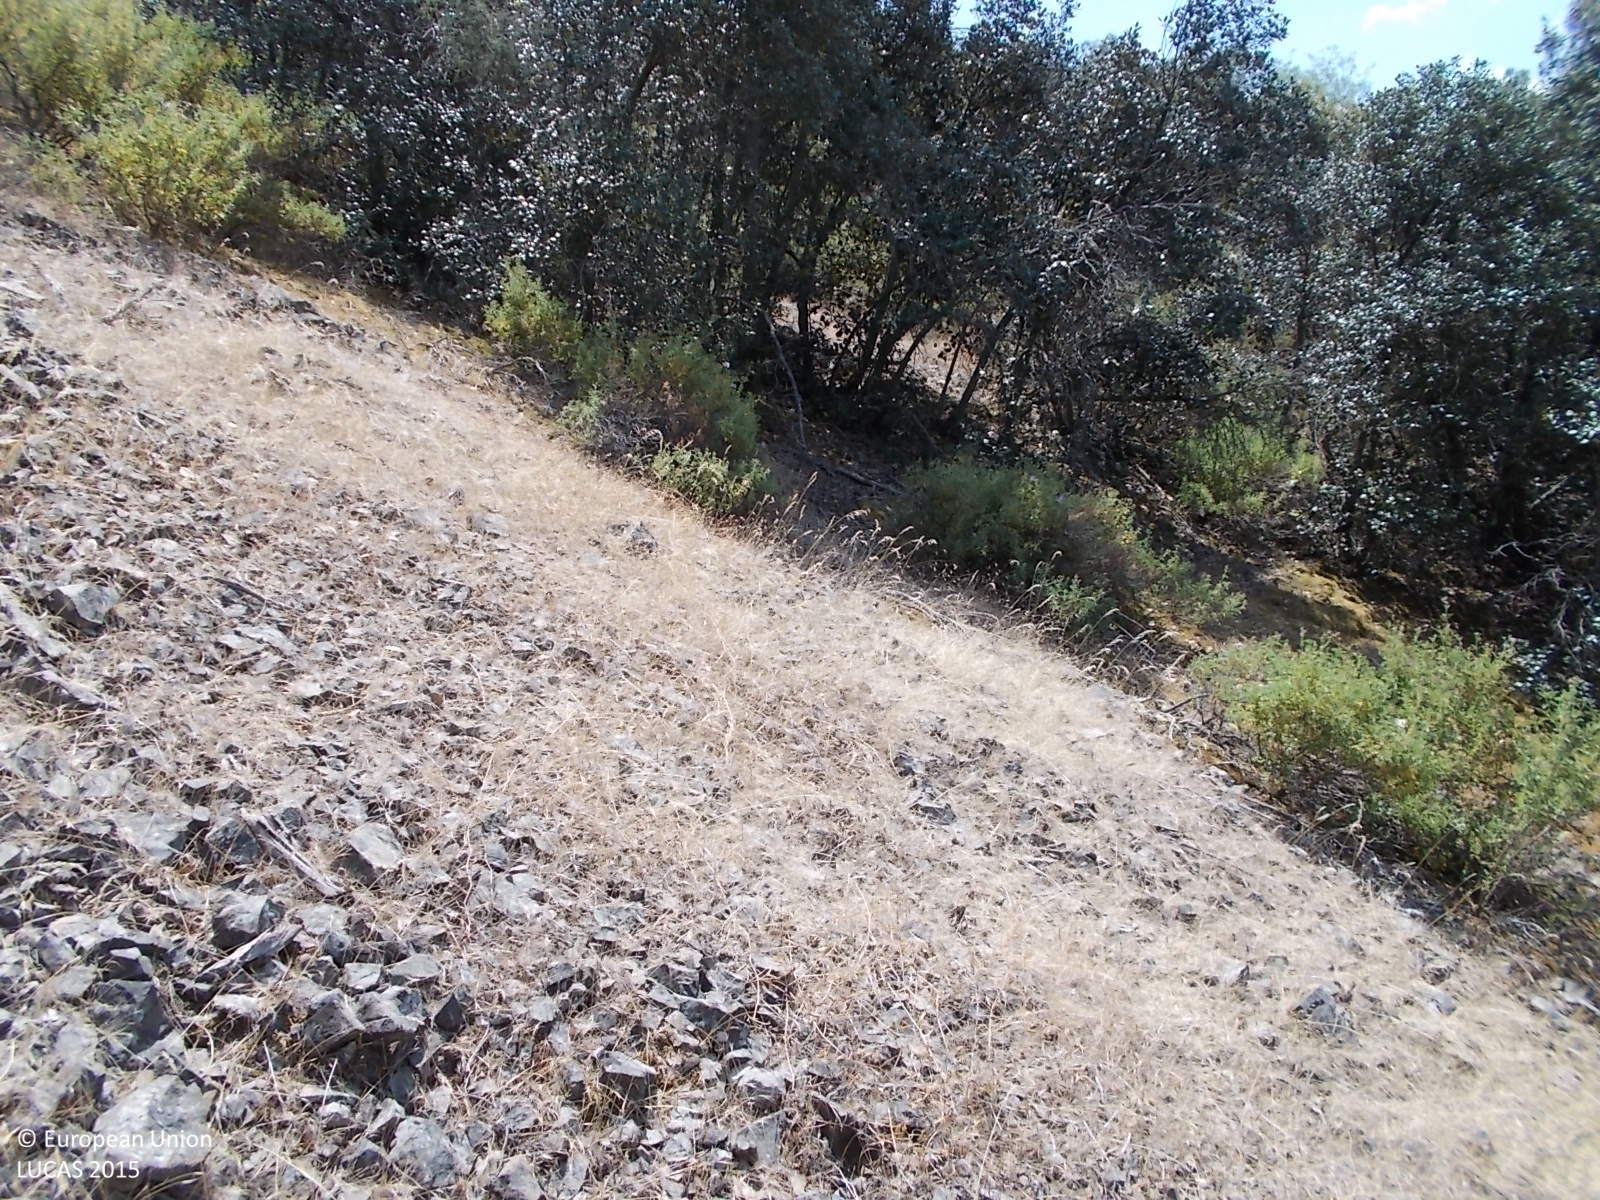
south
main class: Woodland
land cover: Pine dominated mixed woodland
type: coniferous forest of the mediterranean region
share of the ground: 25 - 50 %
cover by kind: coniferous forest trees 35 %, shrubs 20 %, unconsolidated bare surface 20 %, broadleaved forest trees 15 %, consolidated bare surface 10 %
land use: Forestry
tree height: > 5 m
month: June
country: CY
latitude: 35.0064
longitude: 32.9759
